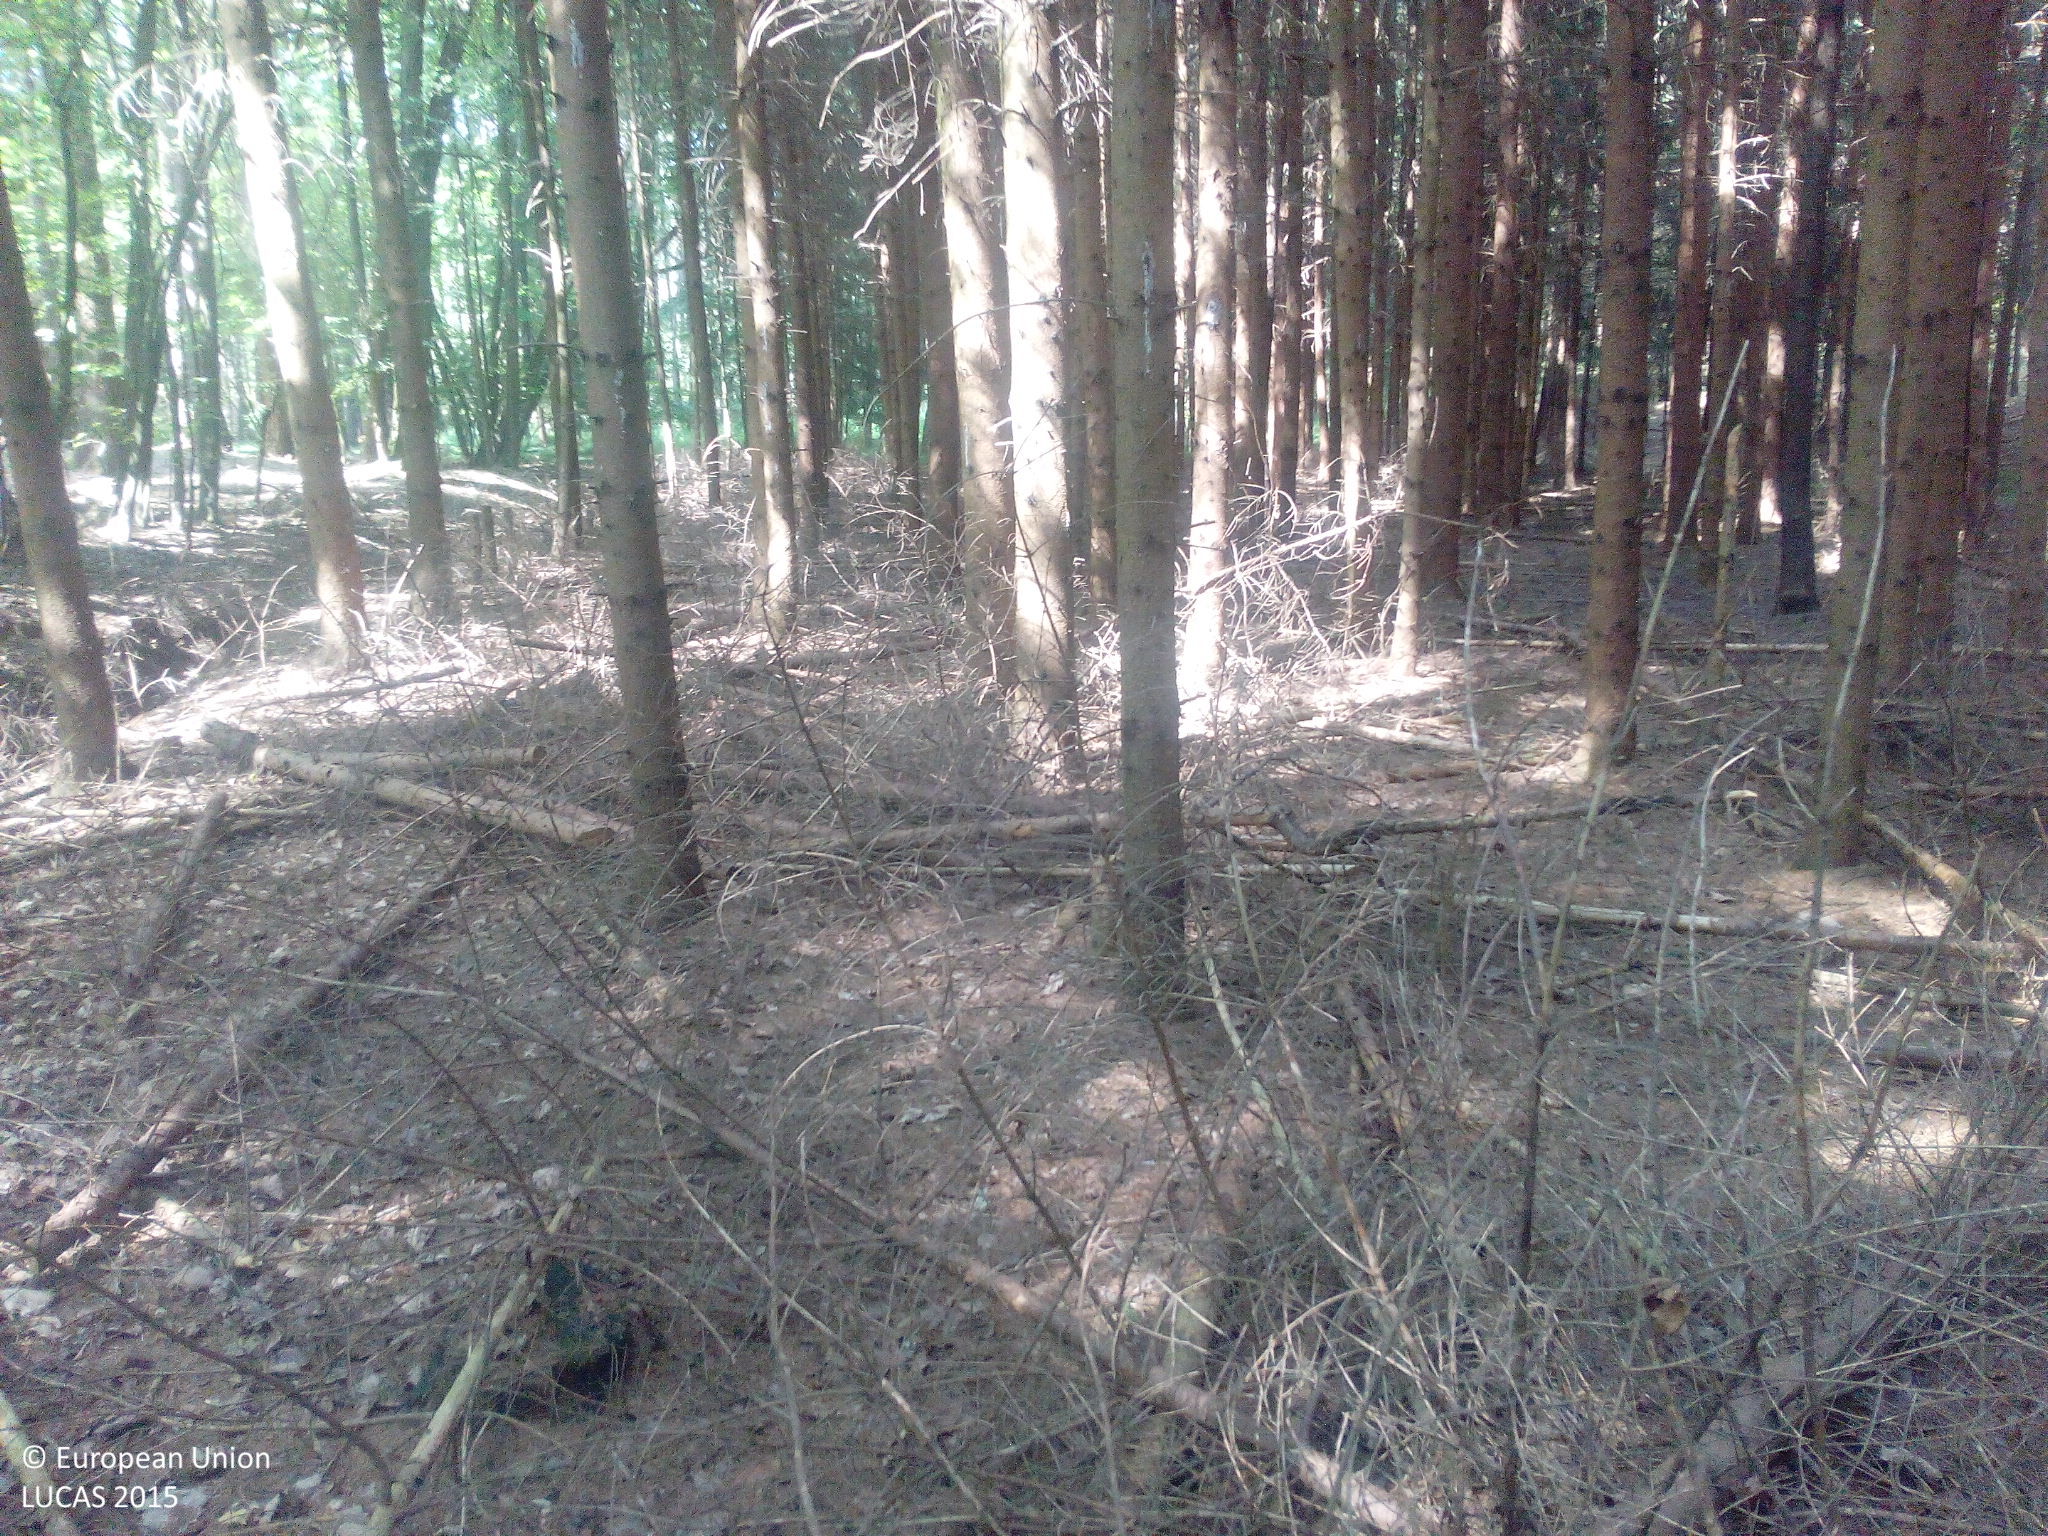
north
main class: Woodland
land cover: Spruce dominated coniferous woodland
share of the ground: > 75 %
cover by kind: coniferous forest trees 95 %, unconsolidated bare surface 5 %
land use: Forestry
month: July
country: DE
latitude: 49.7670
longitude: 10.9022
